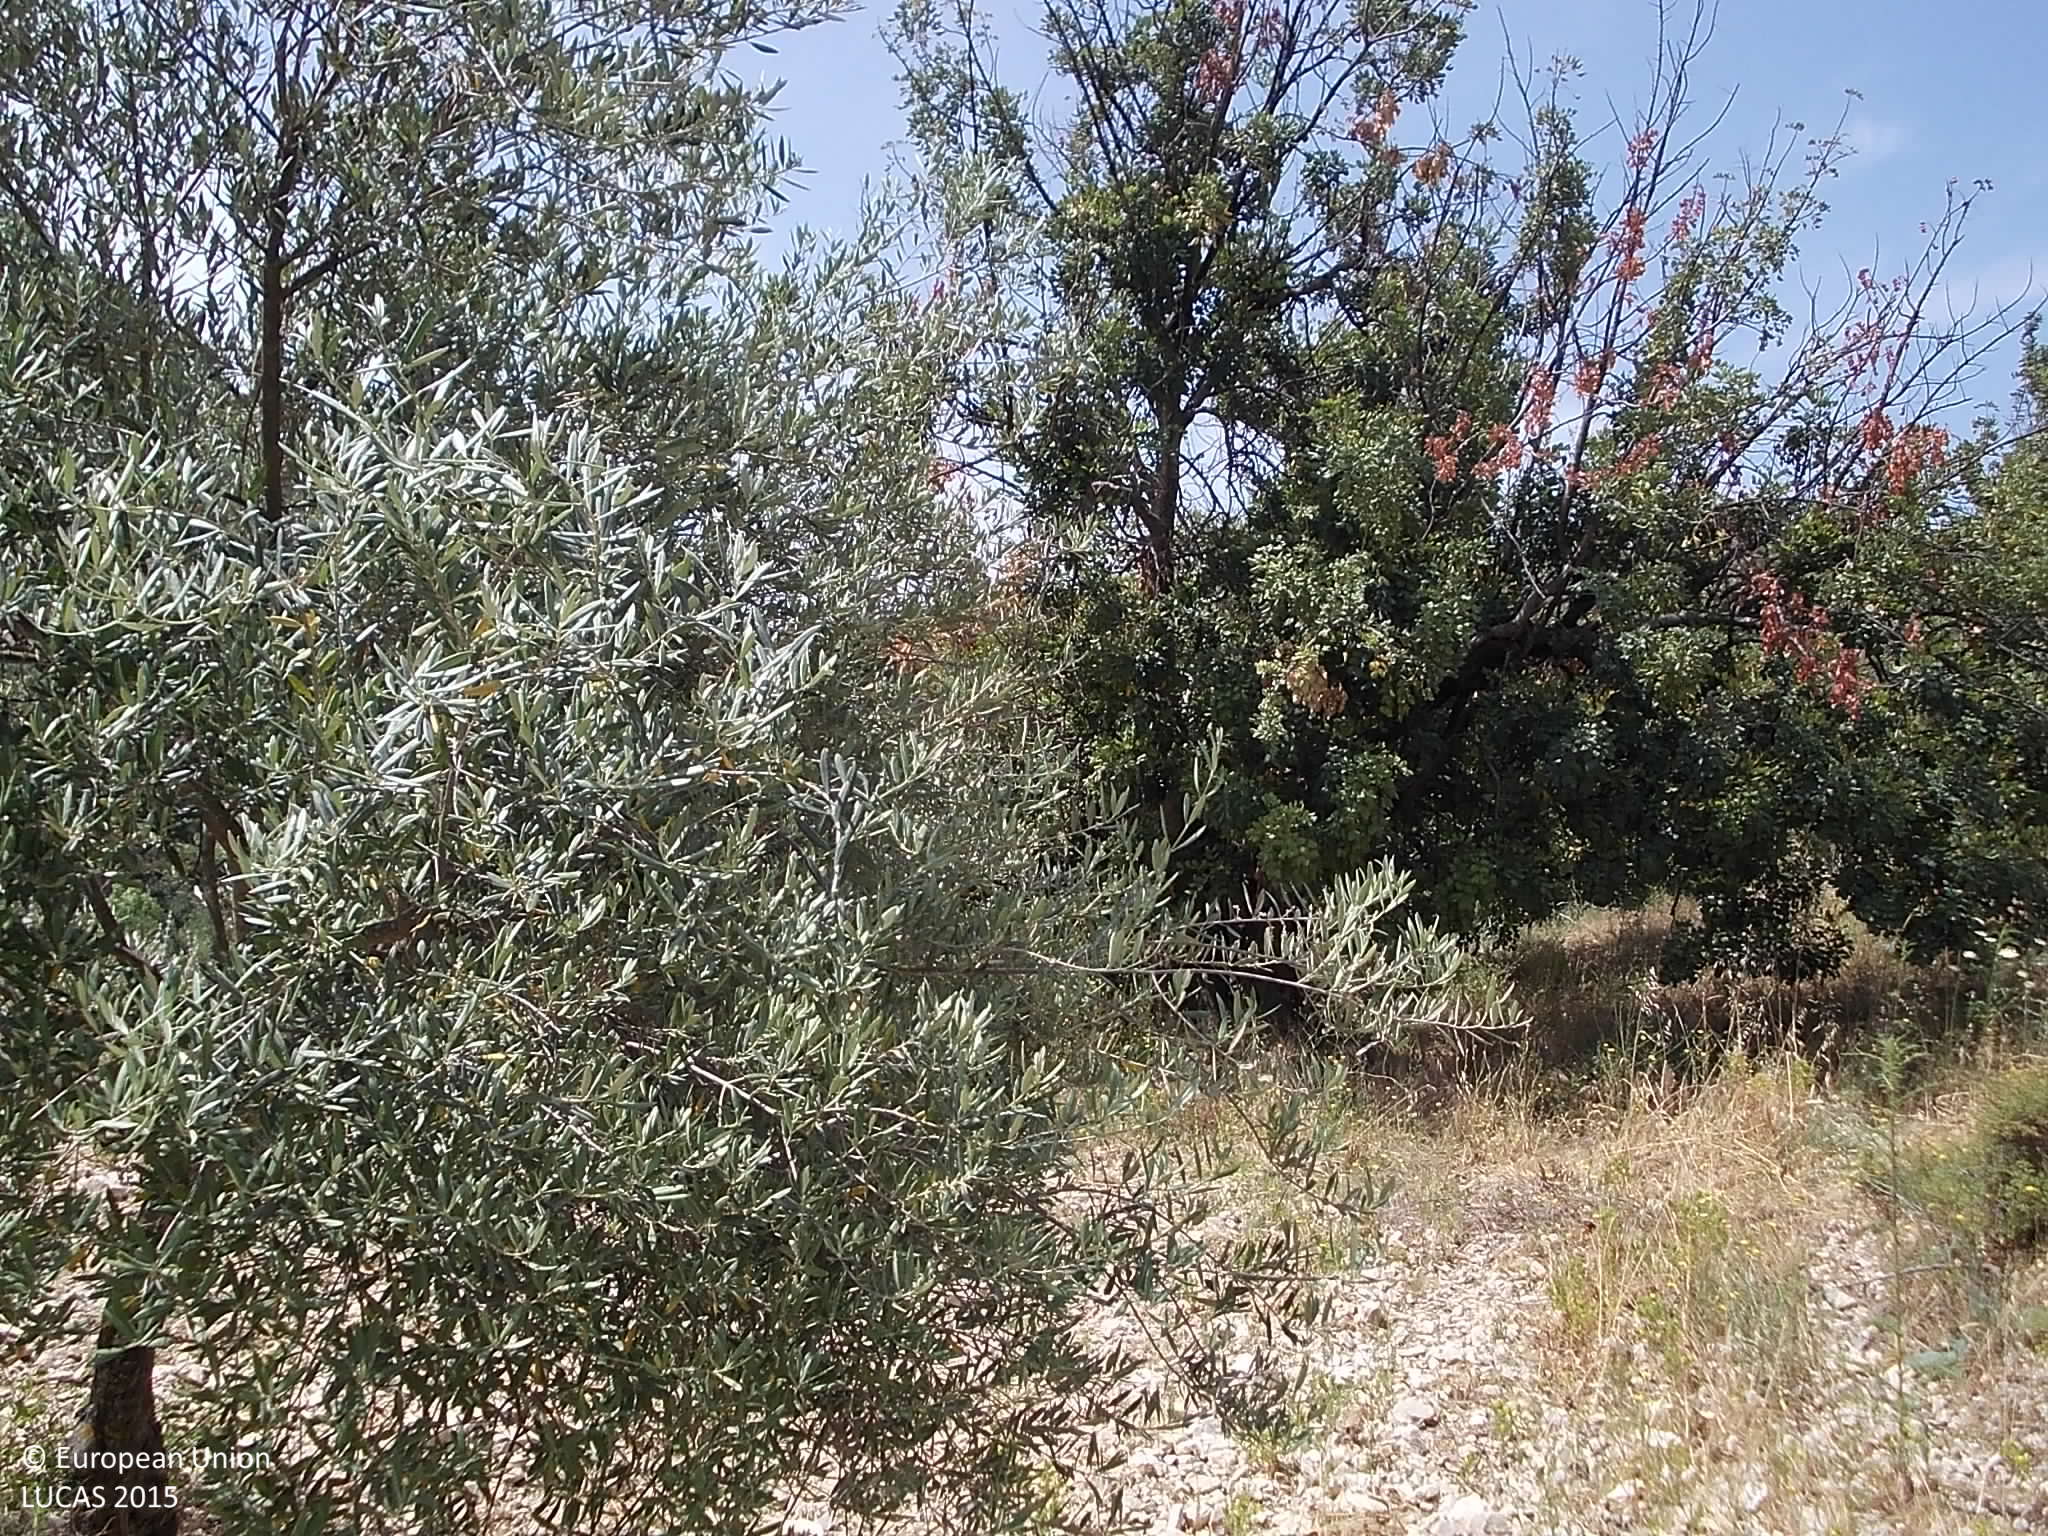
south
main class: Cropland
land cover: Olive groves
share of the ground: 25 - 50 %
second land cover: Rocks and stones
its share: > 75 %
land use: Agriculture (excluding fallow land and kitchen gardens)
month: May
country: CY
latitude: 34.7943
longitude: 32.9986
